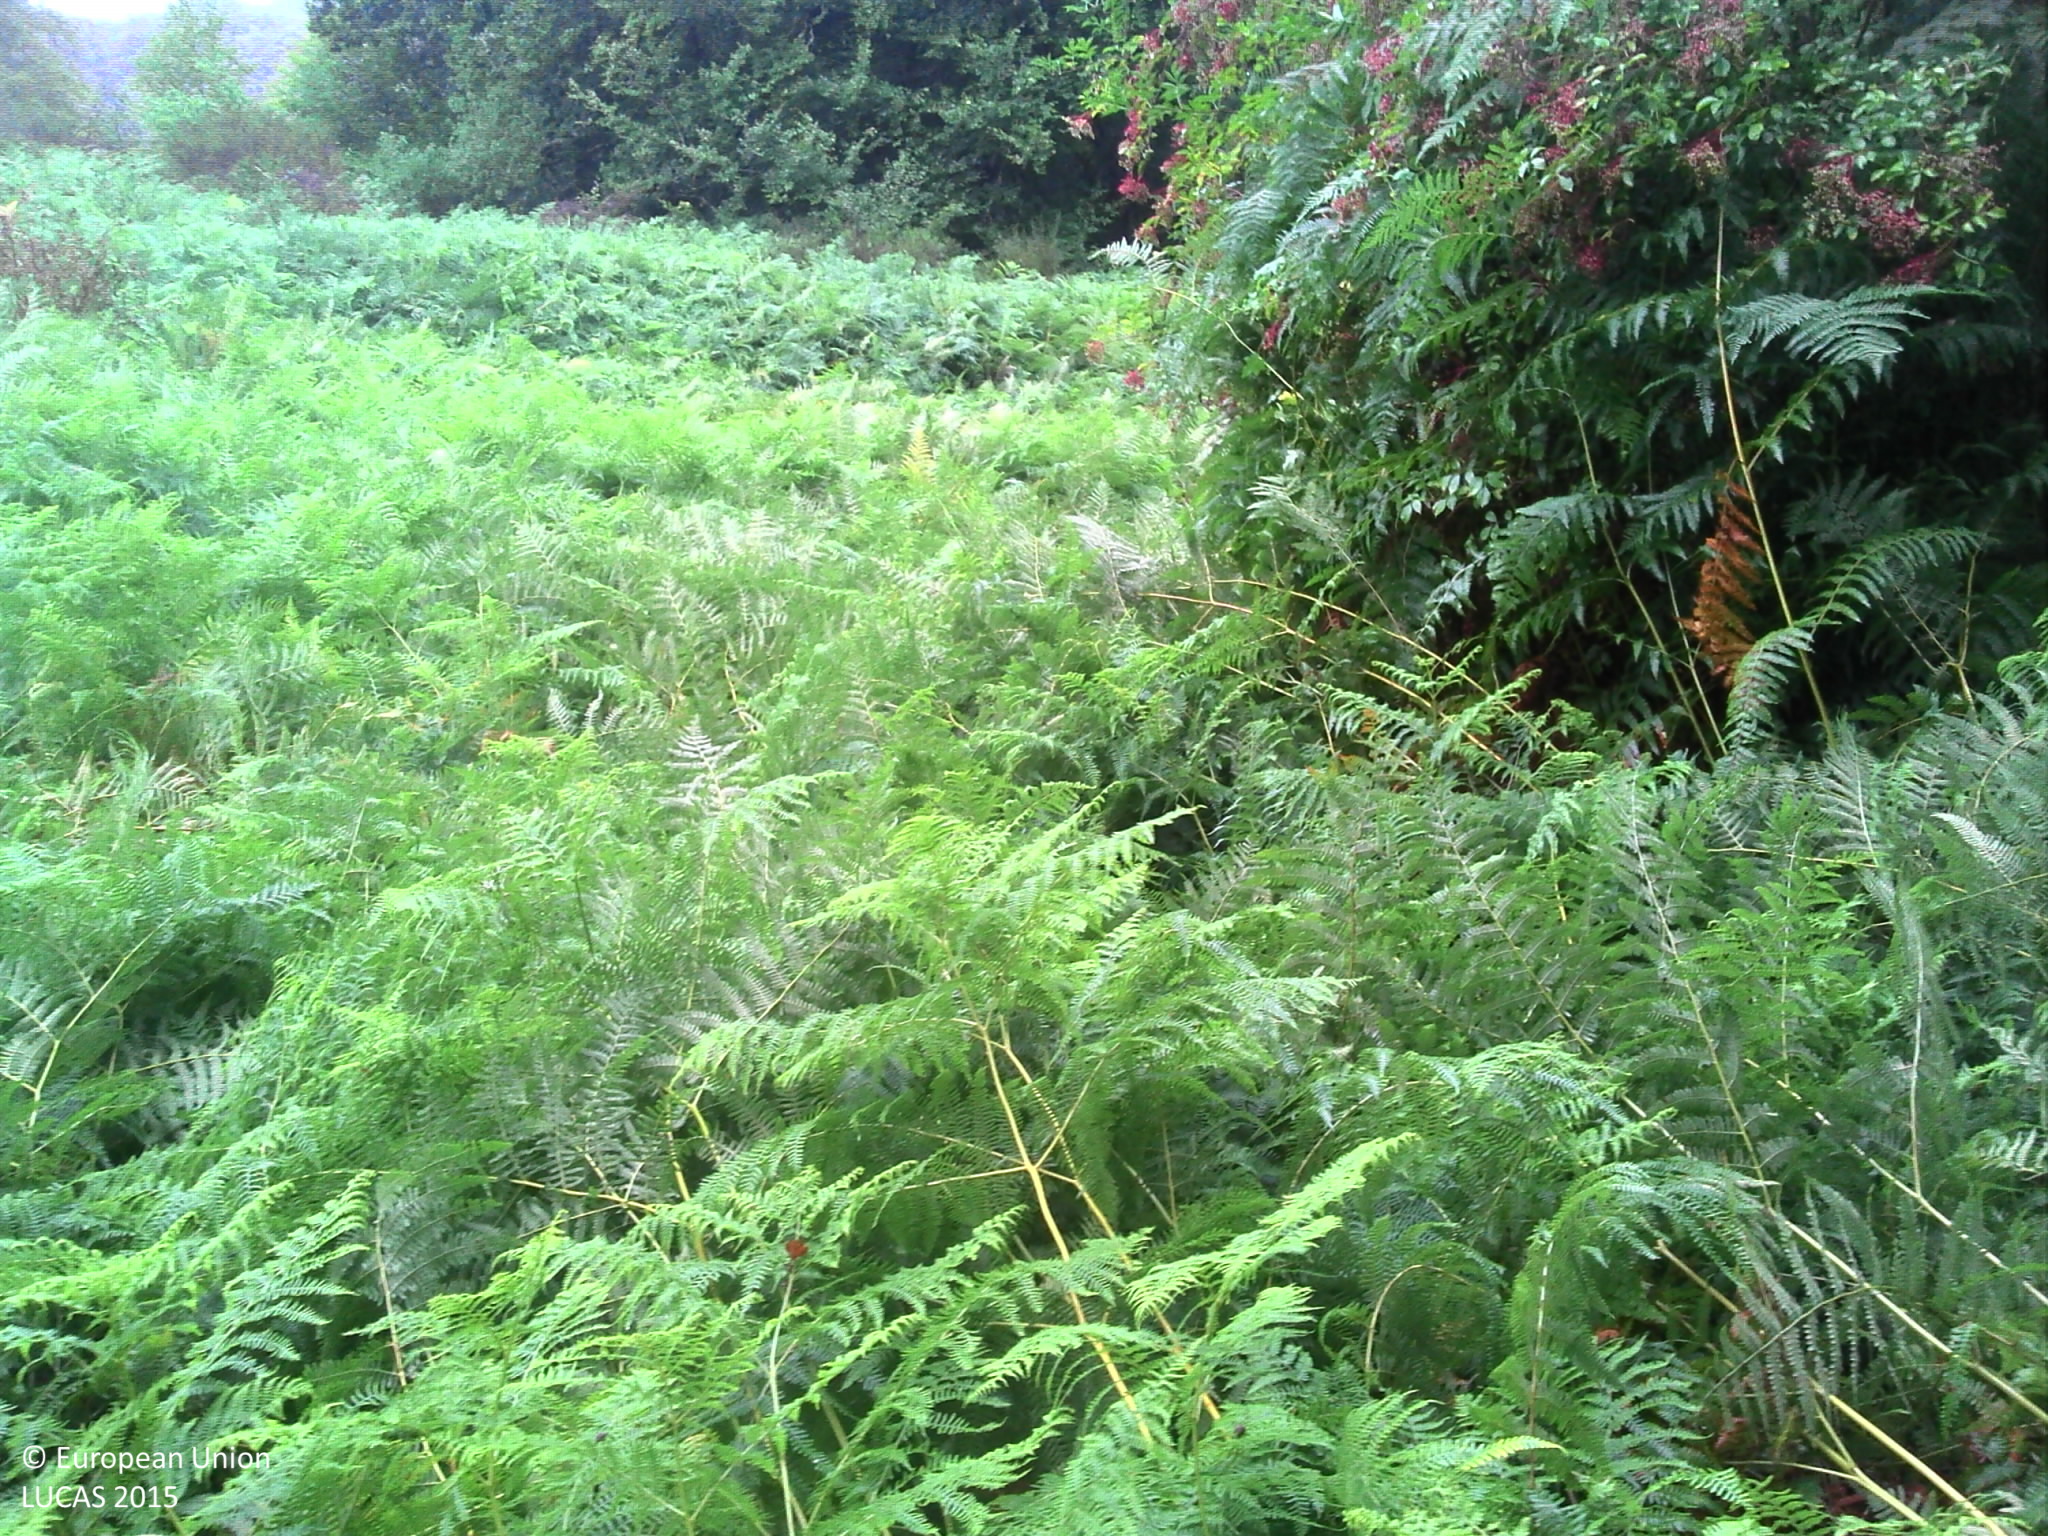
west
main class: Shrubland
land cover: Shrubland without tree cover
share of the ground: > 75 %
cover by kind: shrubs 100 %
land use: Semi-natural and natural areas not in use
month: August
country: FR
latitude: 45.9899
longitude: 1.2240
